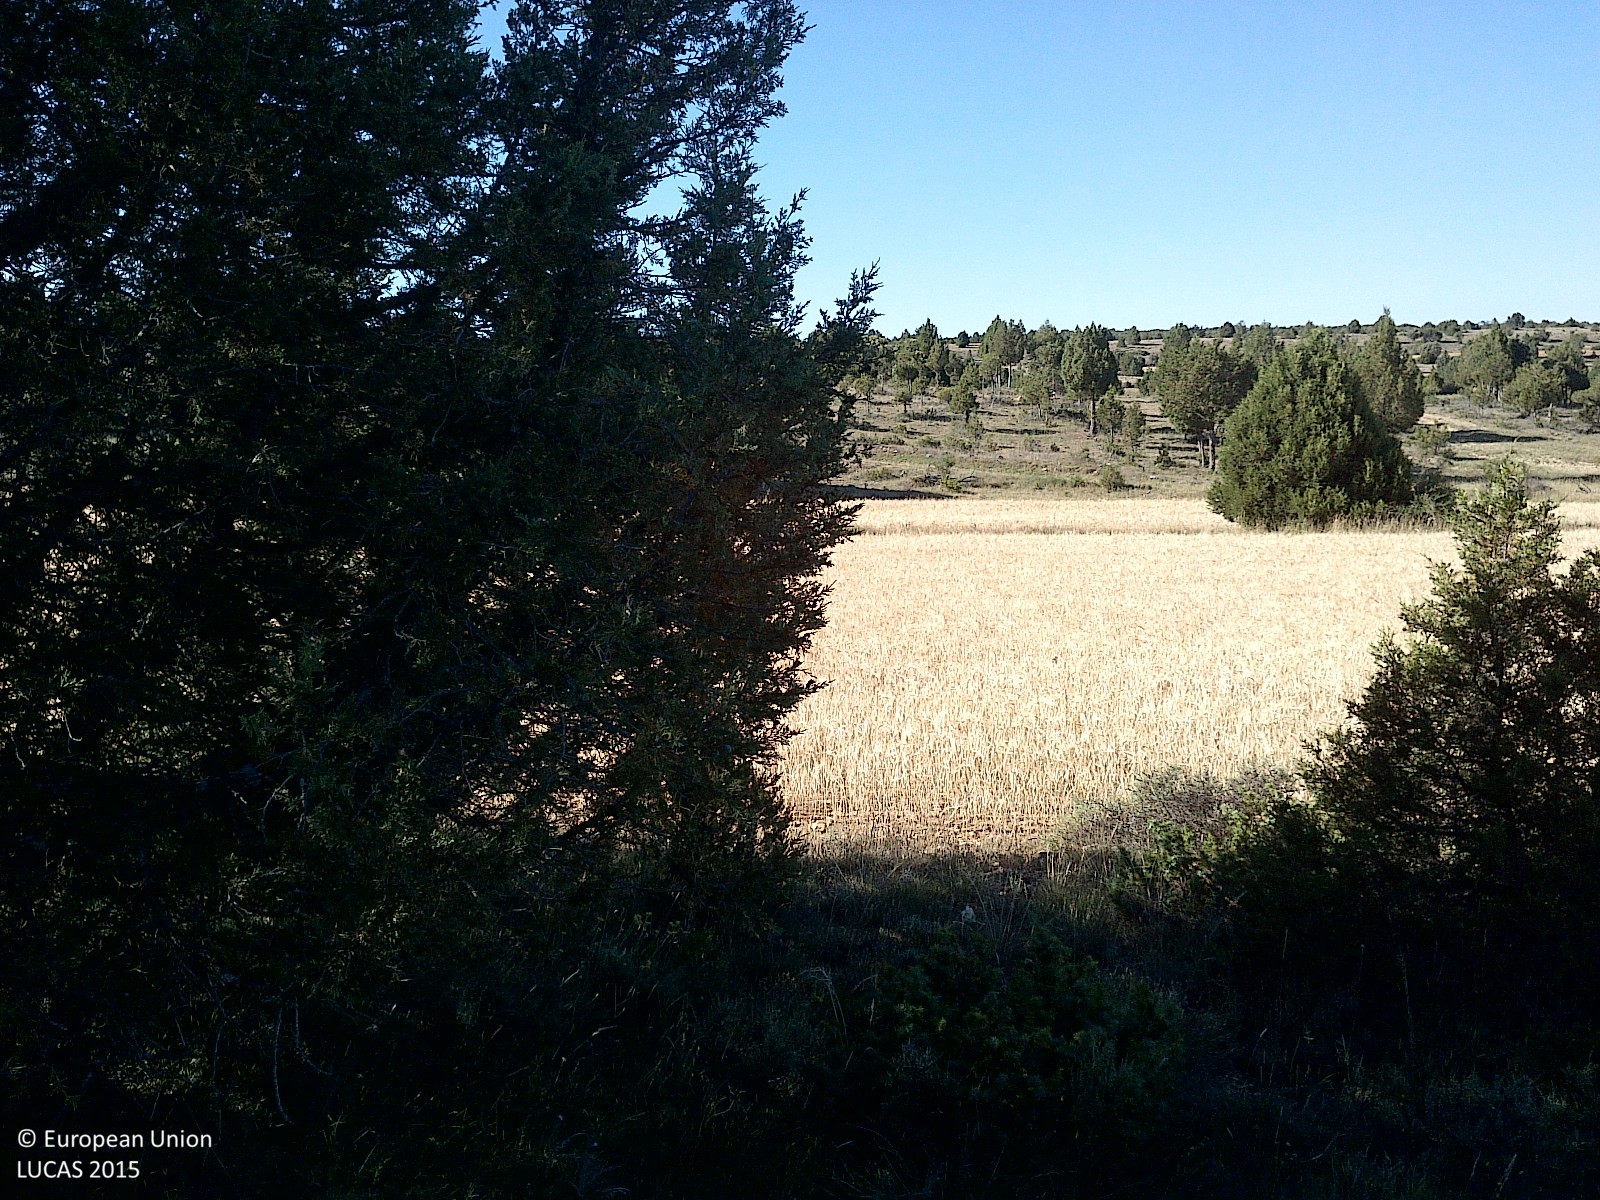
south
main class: Woodland
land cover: Other coniferous woodland
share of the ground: 10 - 25 %
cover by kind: herbaceous plants 65 %, coniferous forest trees 15 %, shrubs 15 %, unconsolidated bare surface 5 %
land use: Semi-natural and natural areas not in use
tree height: < 5 m
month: July
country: ES
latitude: 41.6935
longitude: -2.7893
